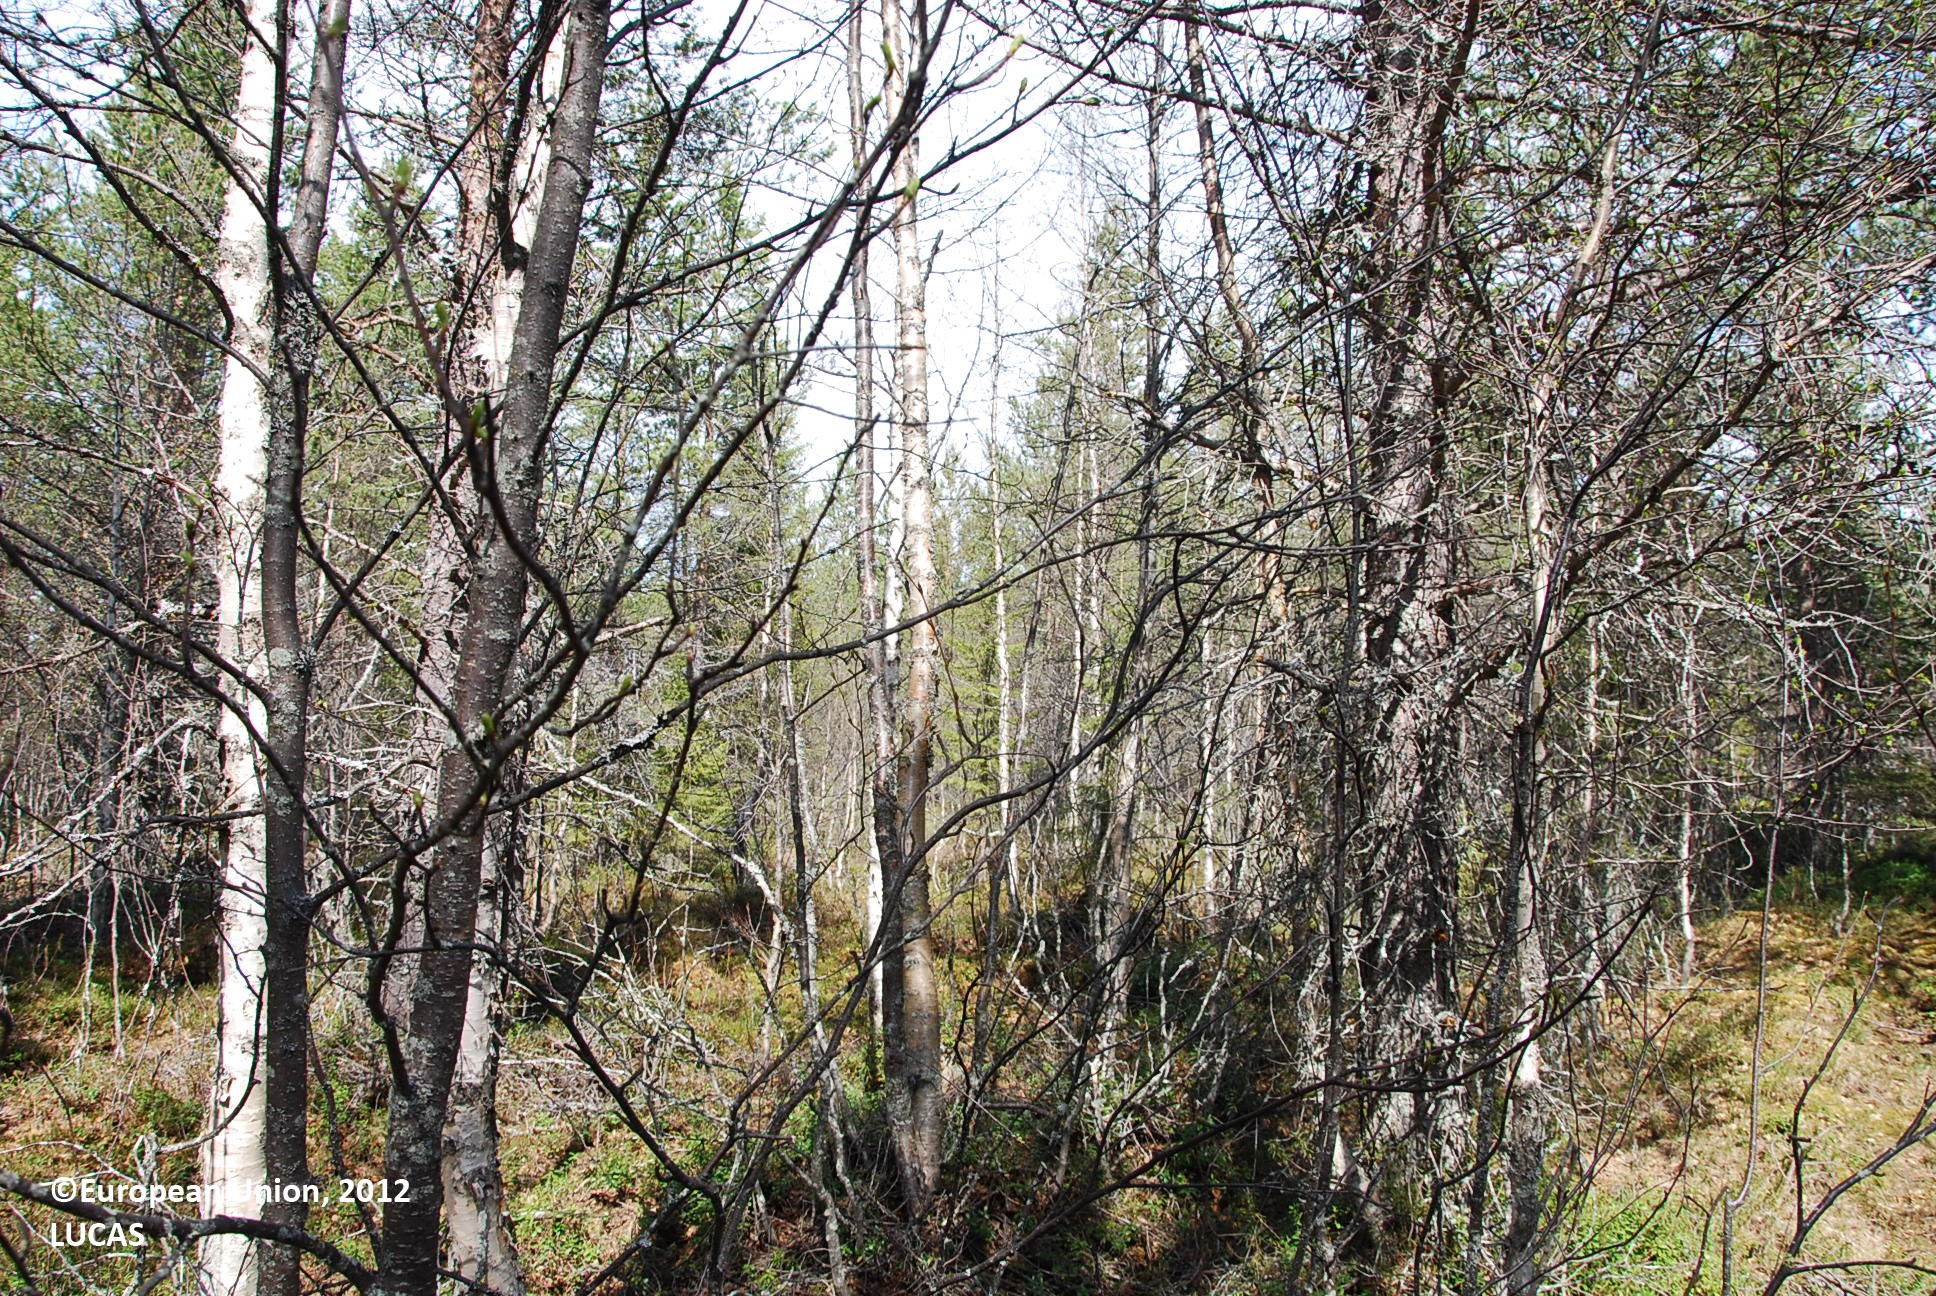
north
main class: Woodland
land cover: Pine dominated mixed woodland
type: boreal forest
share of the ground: > 75 %
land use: Forestry
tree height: > 5 m
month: May
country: FI
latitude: 66.6956
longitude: 28.7012
